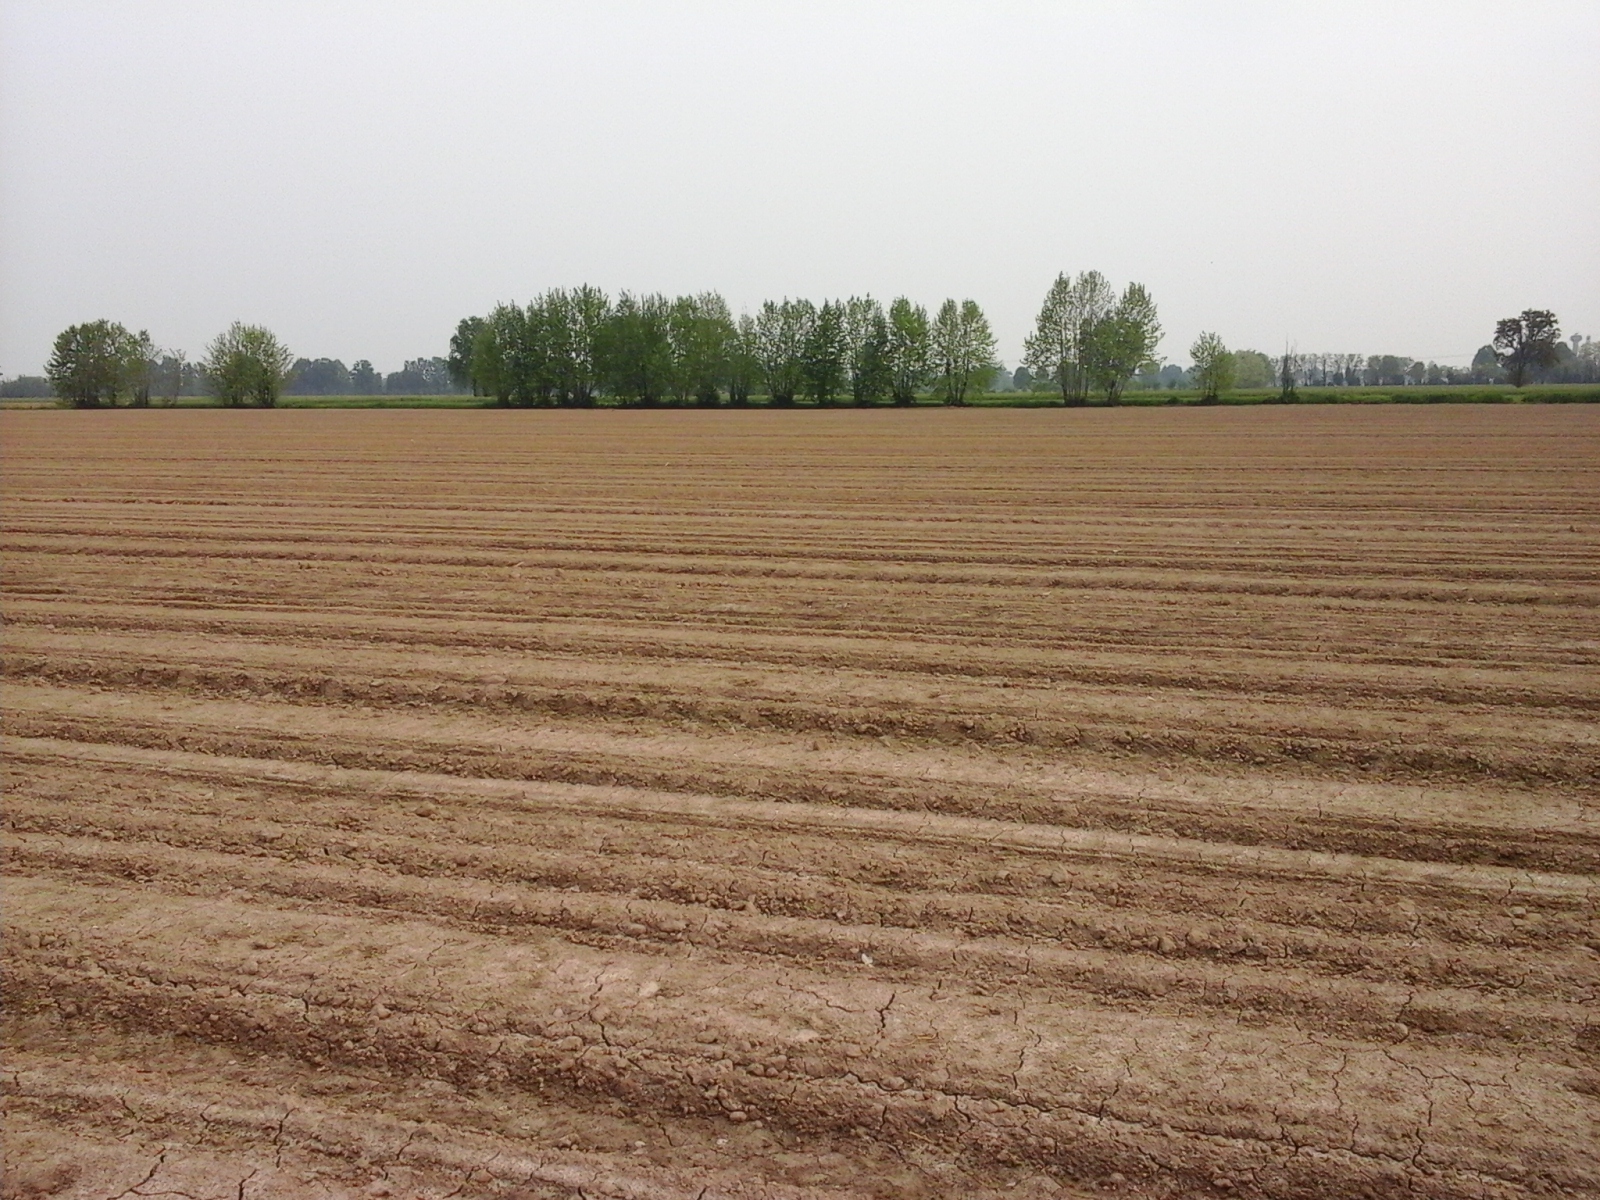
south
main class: Cropland
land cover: Maize
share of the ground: < 10 %
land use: Agriculture (excluding fallow land and kitchen gardens)
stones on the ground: < 10 %
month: May
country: IT
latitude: 45.1258
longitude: 10.1650
